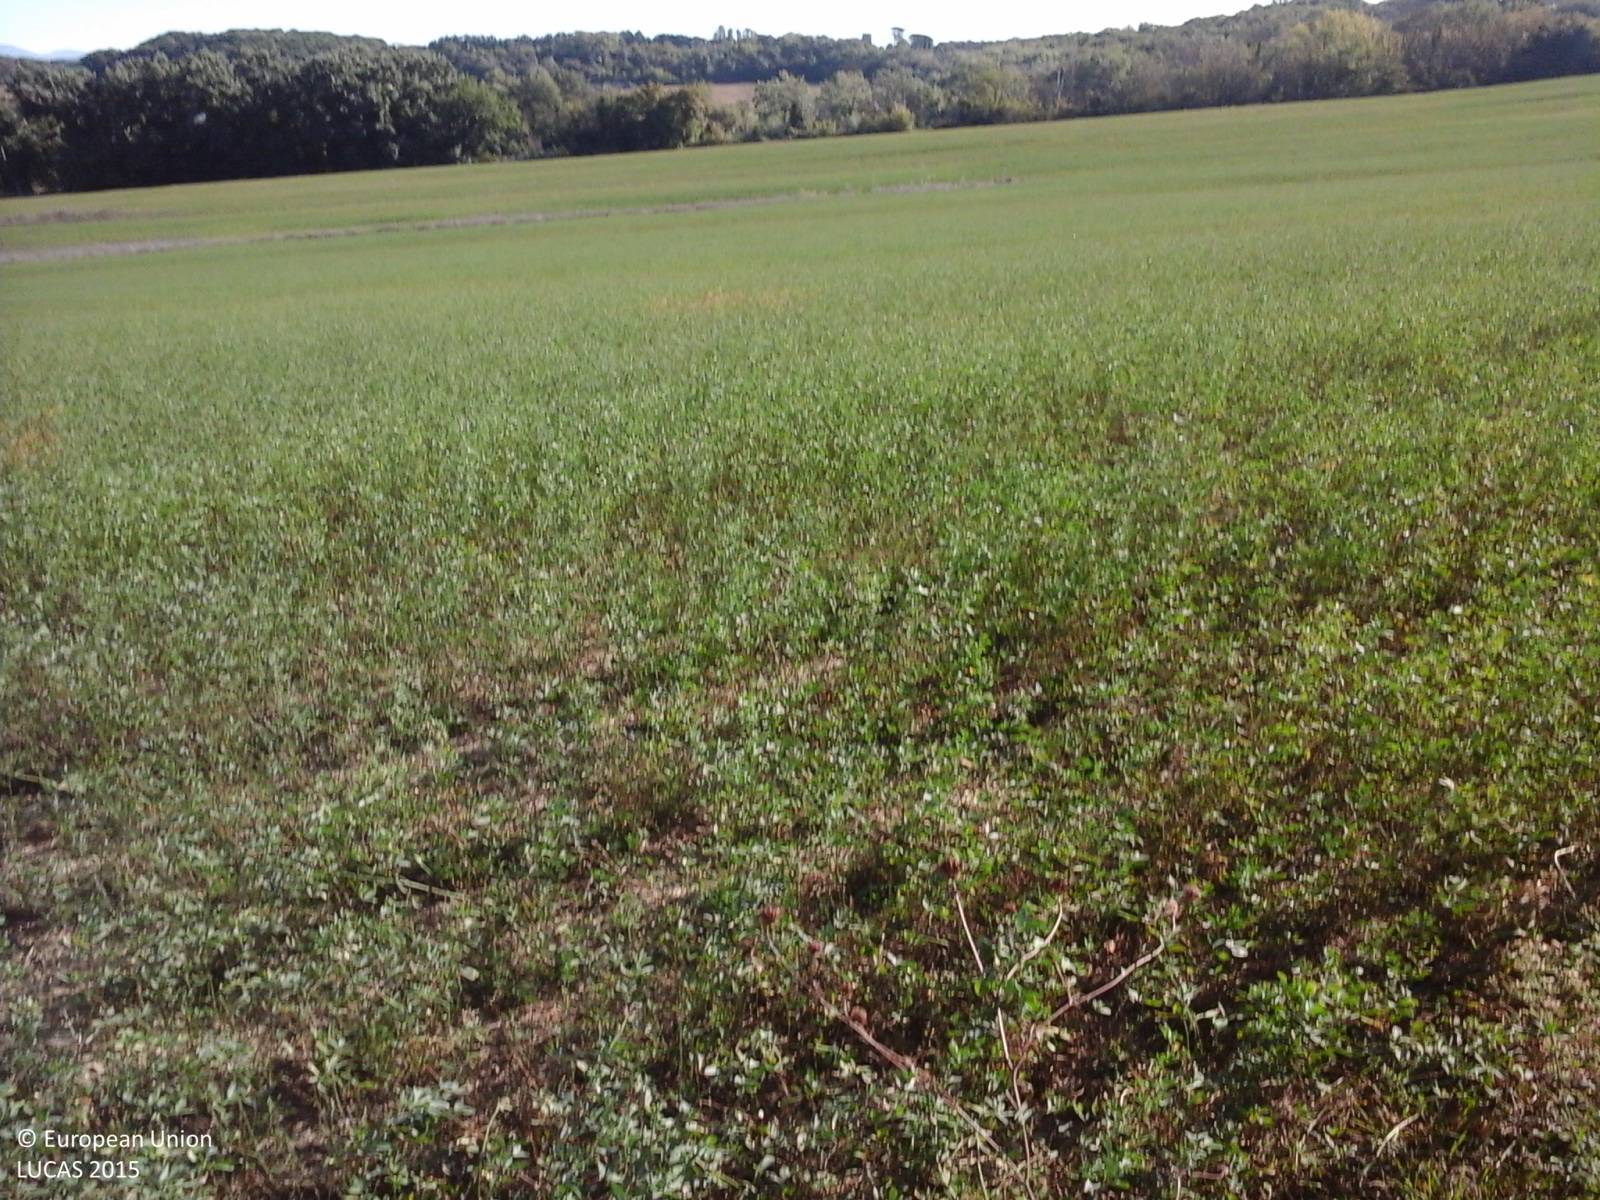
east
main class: Cropland
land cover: Lucerne
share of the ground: > 75 %
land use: Agriculture (excluding fallow land and kitchen gardens)
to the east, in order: Lucerne; Broadleaved woodland; Ditches and canals; Other bare soil
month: September
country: IT
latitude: 42.4813
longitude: 12.3885
